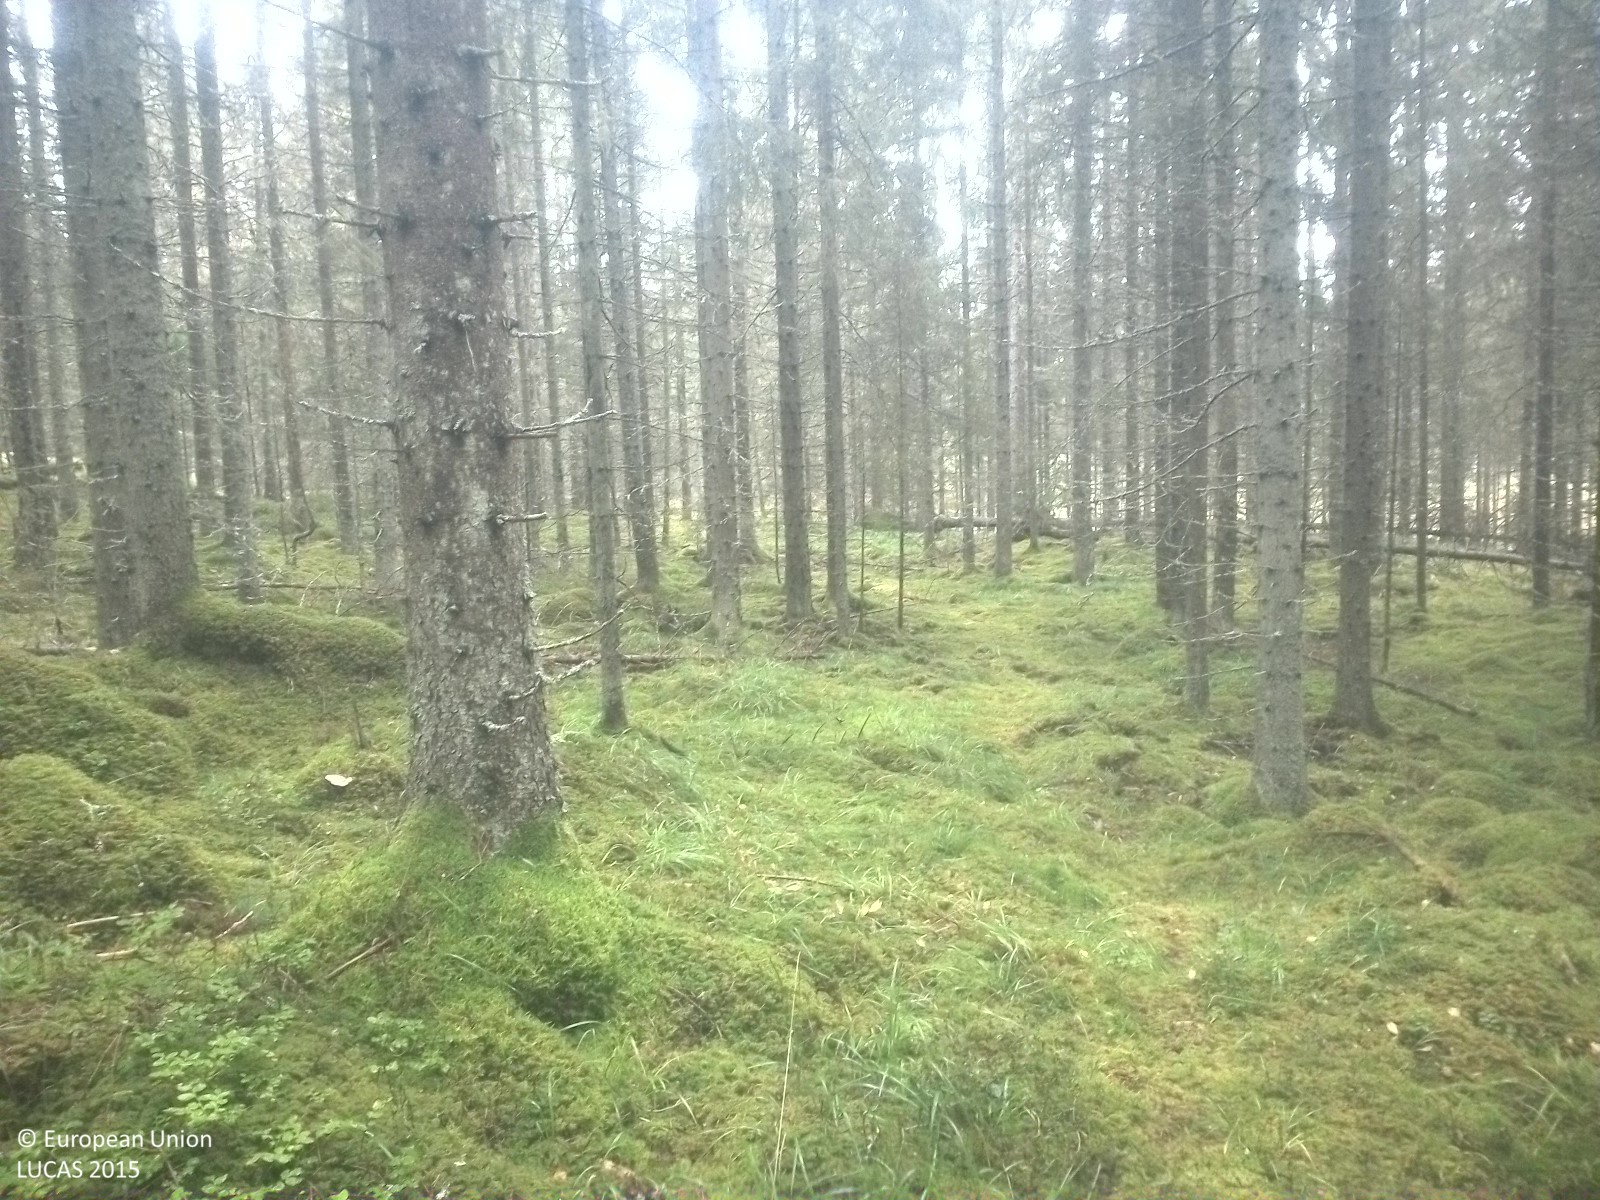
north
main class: Woodland
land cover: Spruce dominated coniferous woodland
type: boreal forest
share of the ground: 50 - 75 %
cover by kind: coniferous forest trees 55 %, lichens and mosses 40 %, herbaceous plants 5 %
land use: Forestry
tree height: > 5 m
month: September
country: SE
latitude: 58.8357
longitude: 15.7627
